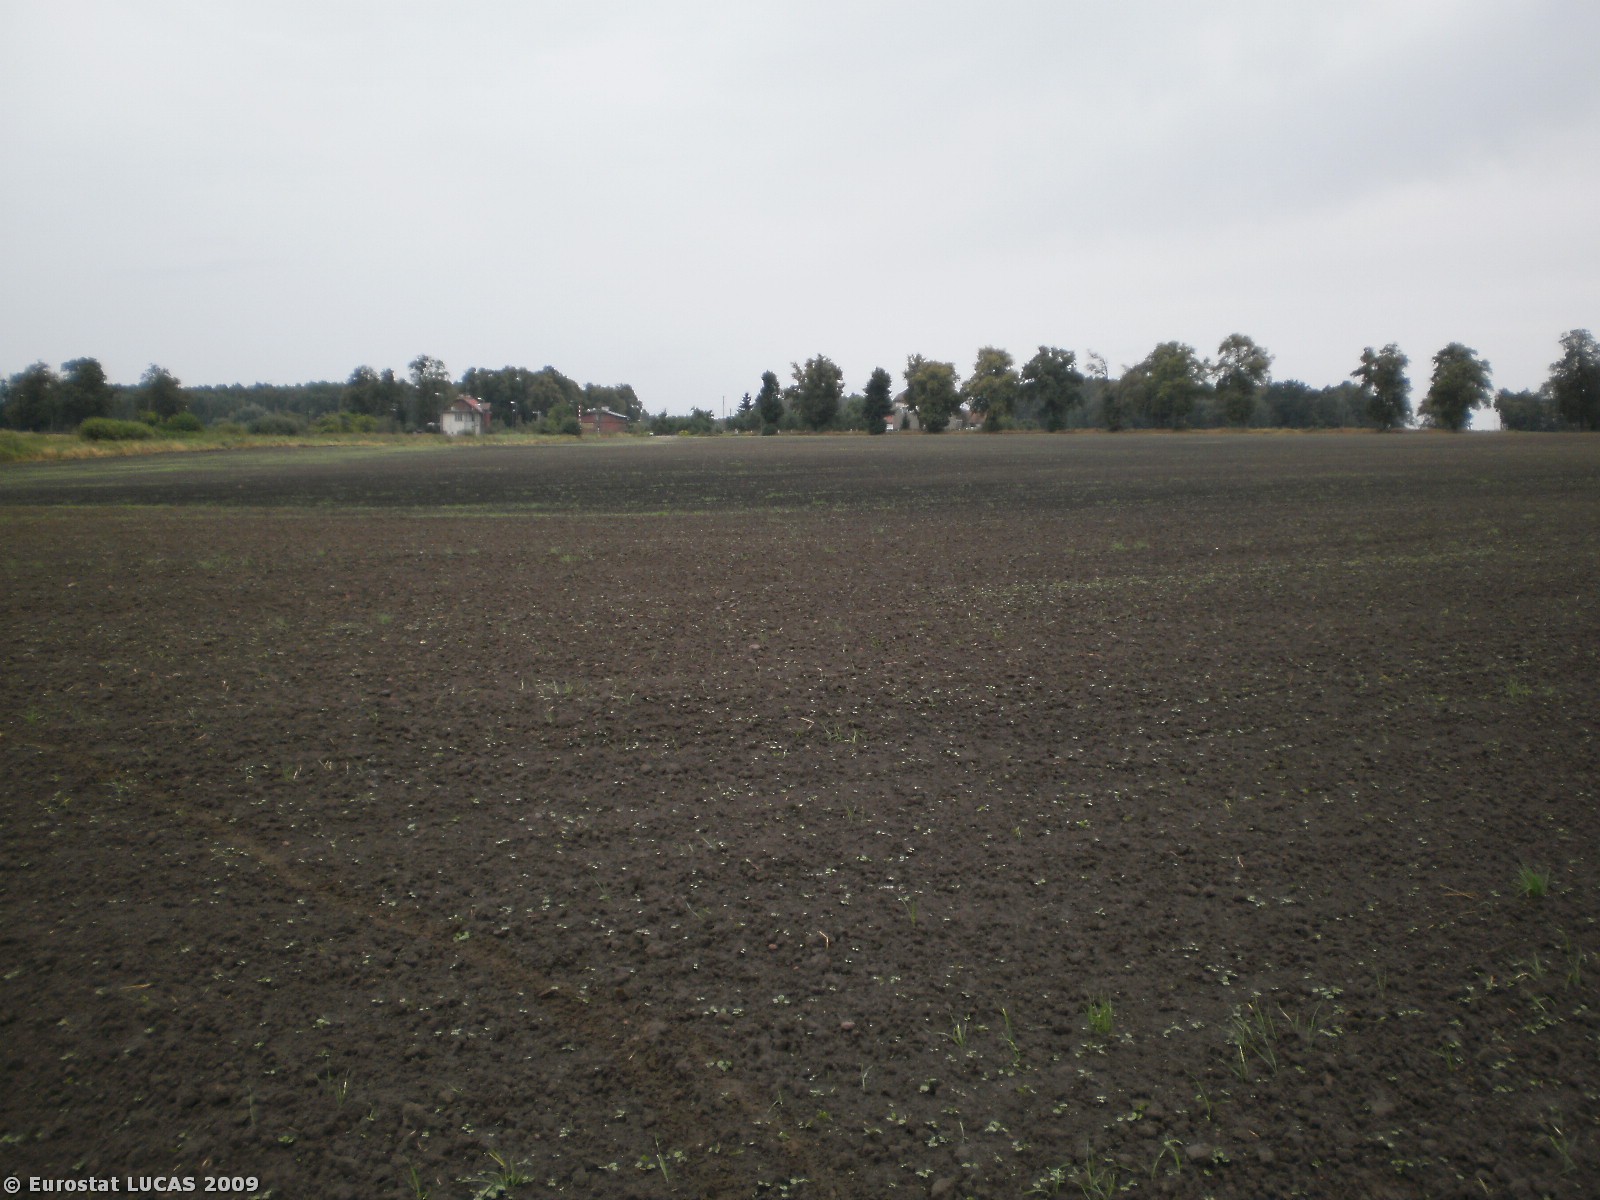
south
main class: Cropland
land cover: Common wheat
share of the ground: < 10 %
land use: Agriculture (excluding fallow land and kitchen gardens)
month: August
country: PL
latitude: 54.2723
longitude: 21.2710
